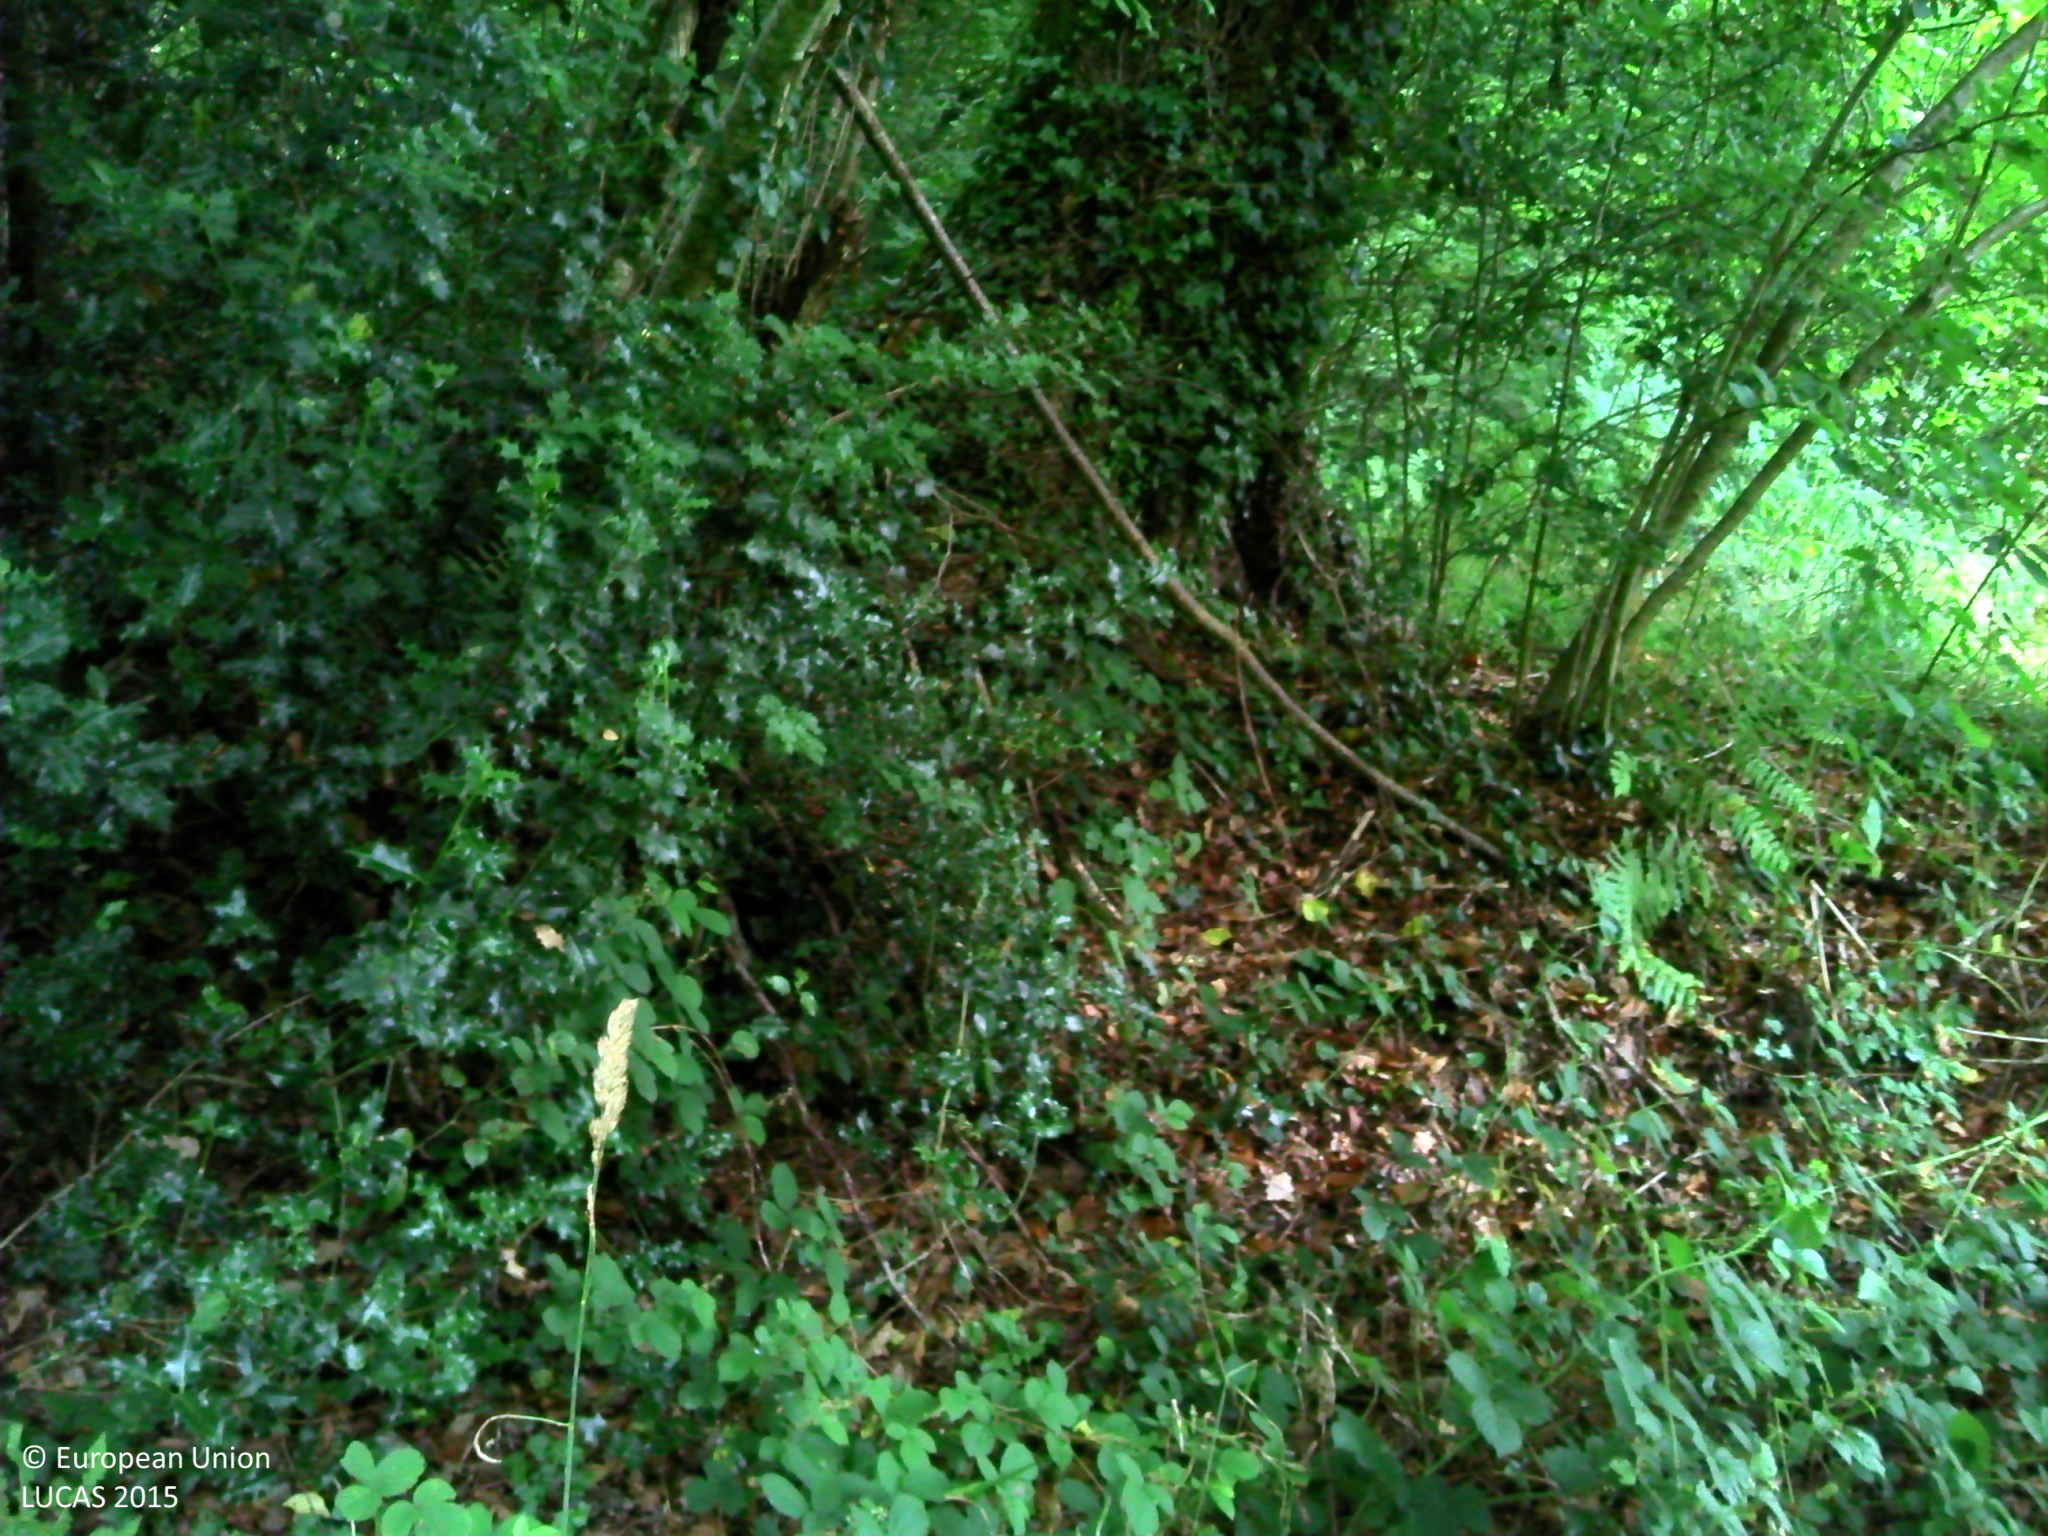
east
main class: Woodland
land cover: Broadleaved woodland
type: mesophytic deciduous forest
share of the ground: > 75 %
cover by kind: broadleaved forest trees 65 %, herbaceous plants 20 %, consolidated bare surface 10 %, lichens and mosses 5 %
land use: Forestry
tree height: > 5 m
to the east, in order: Broadleaved woodland; Spontaneously vegetated surfaces; Broadleaved woodland; Electric lines; Fences; Grass margins; Paved roads, cycling and walking lanes; Grass margins; Ditches and canals; Broadleaved woodland
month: July
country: FR
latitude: 47.8731
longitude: -3.2678
